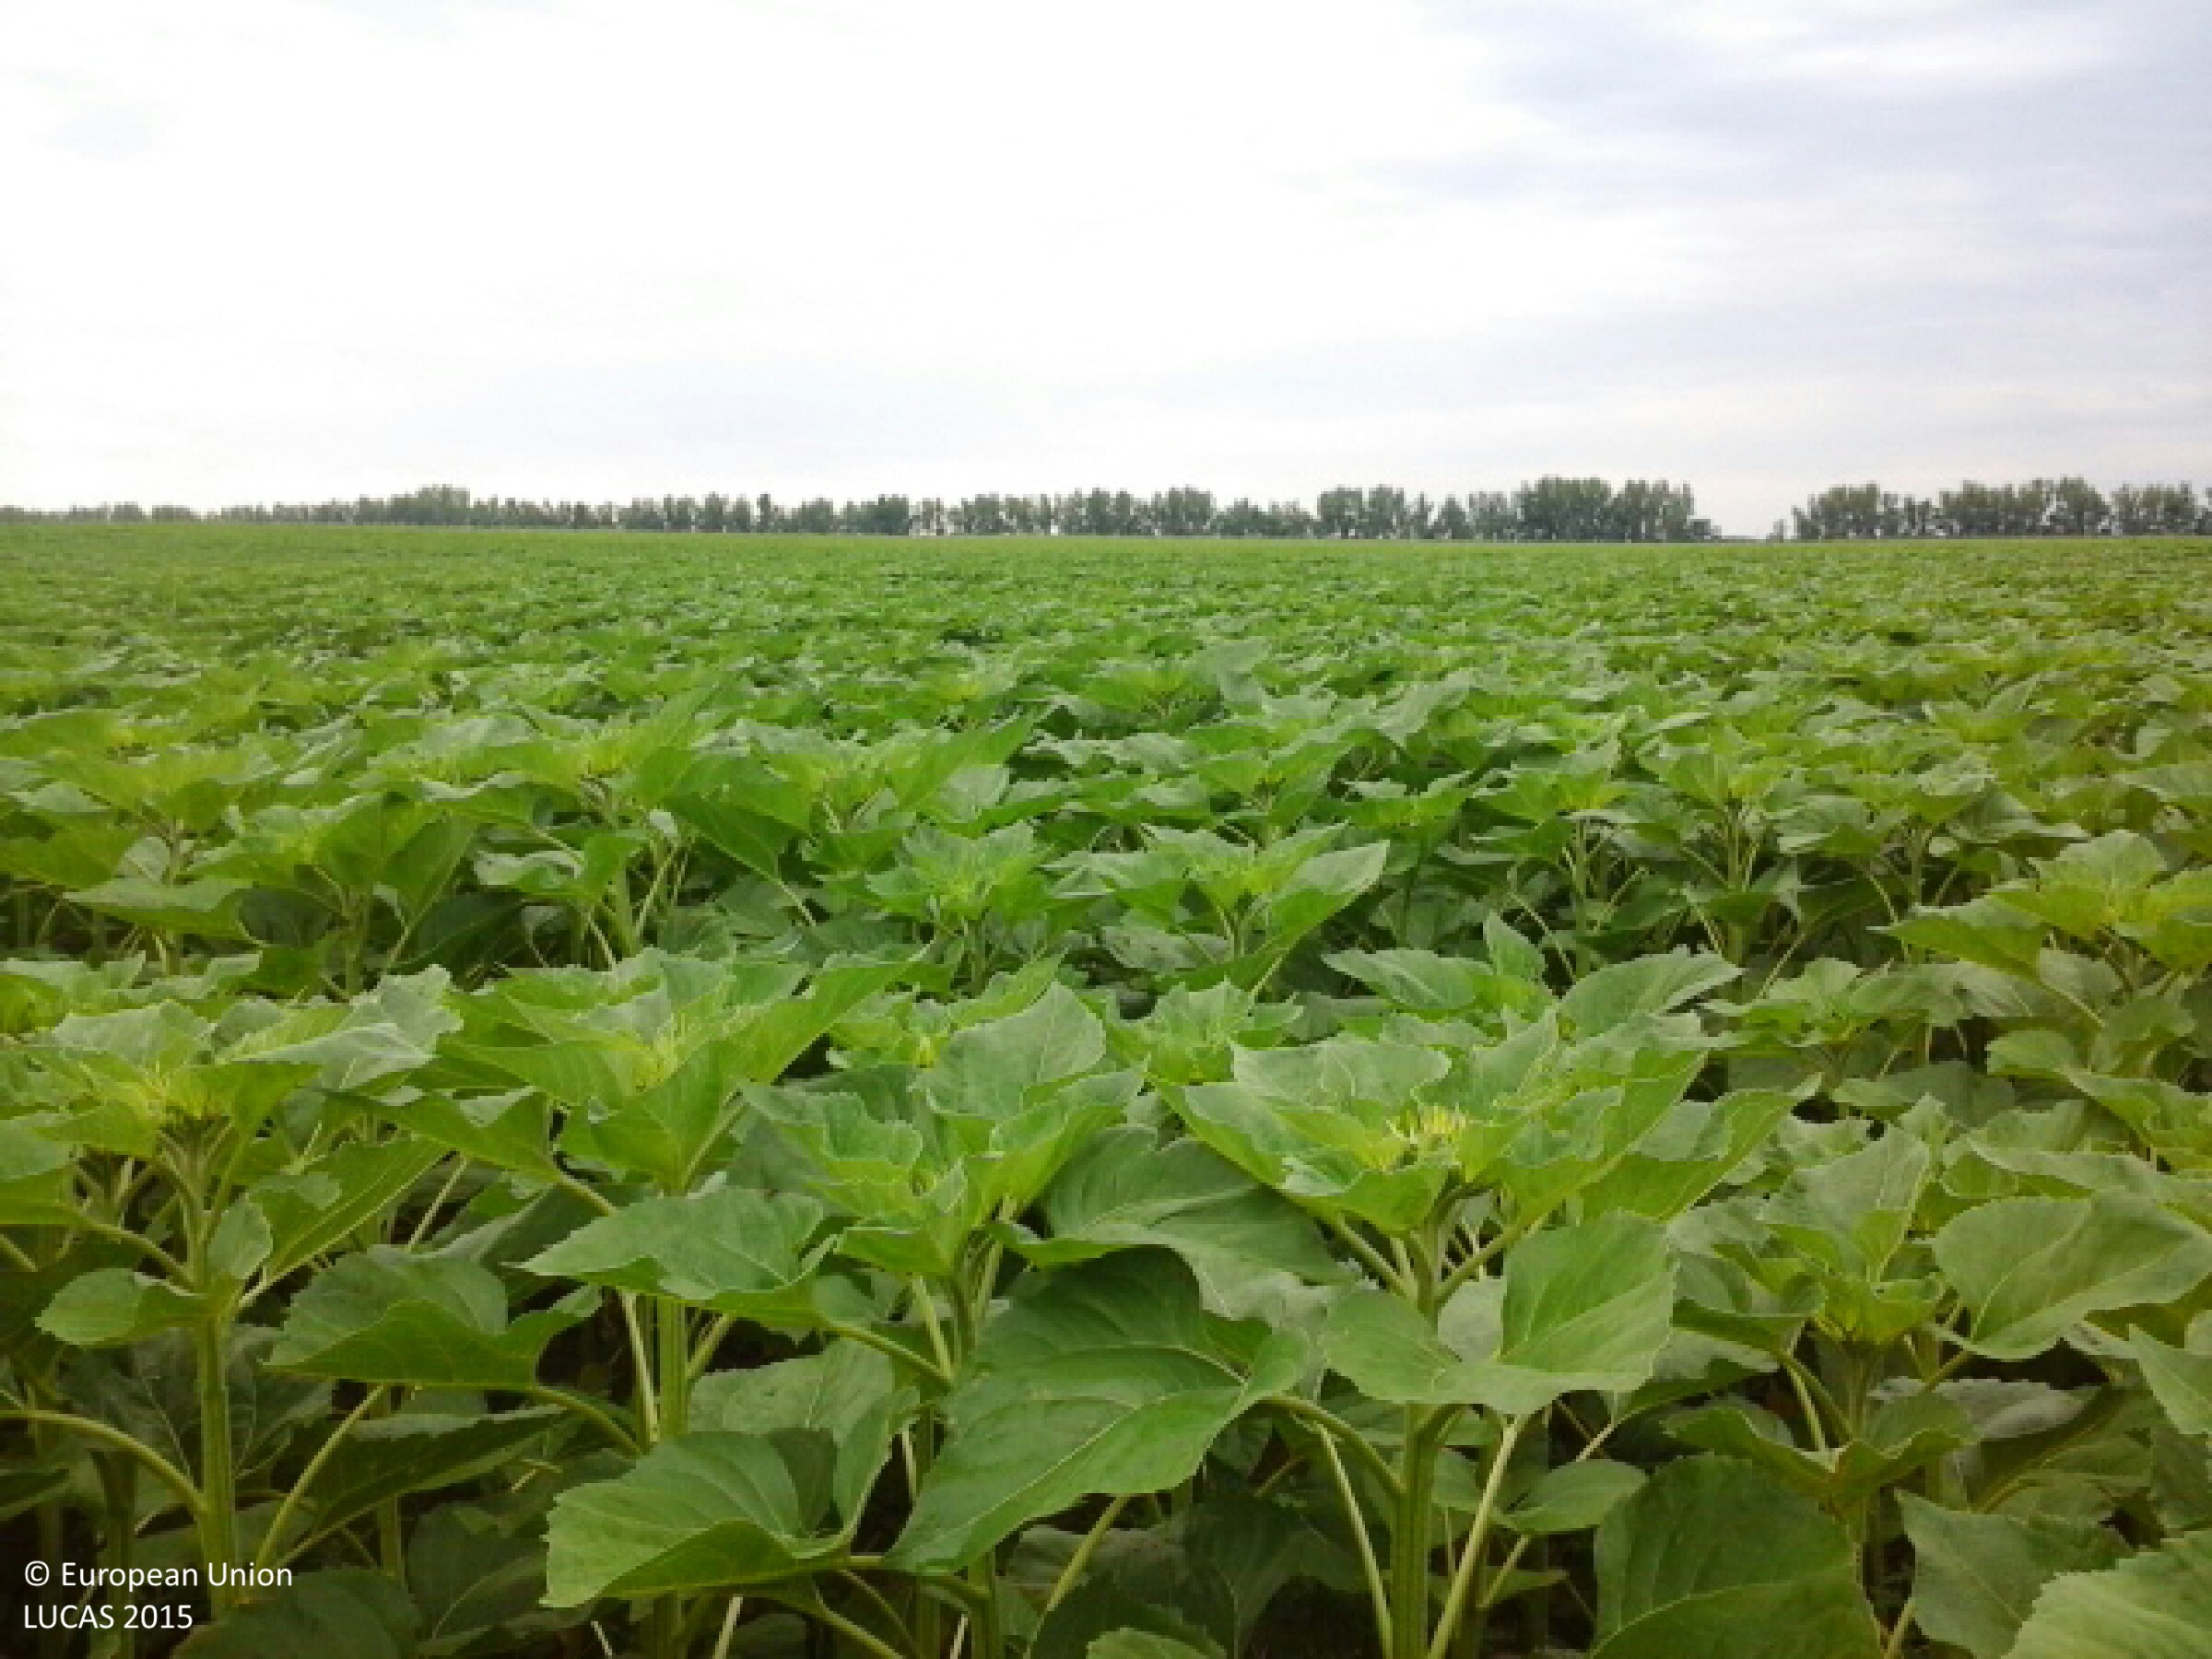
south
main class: Cropland
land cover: Sunflower
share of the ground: > 75 %
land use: Agriculture (excluding fallow land and kitchen gardens)
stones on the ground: < 10 %
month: June
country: HU
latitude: 48.1398
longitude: 21.5637
